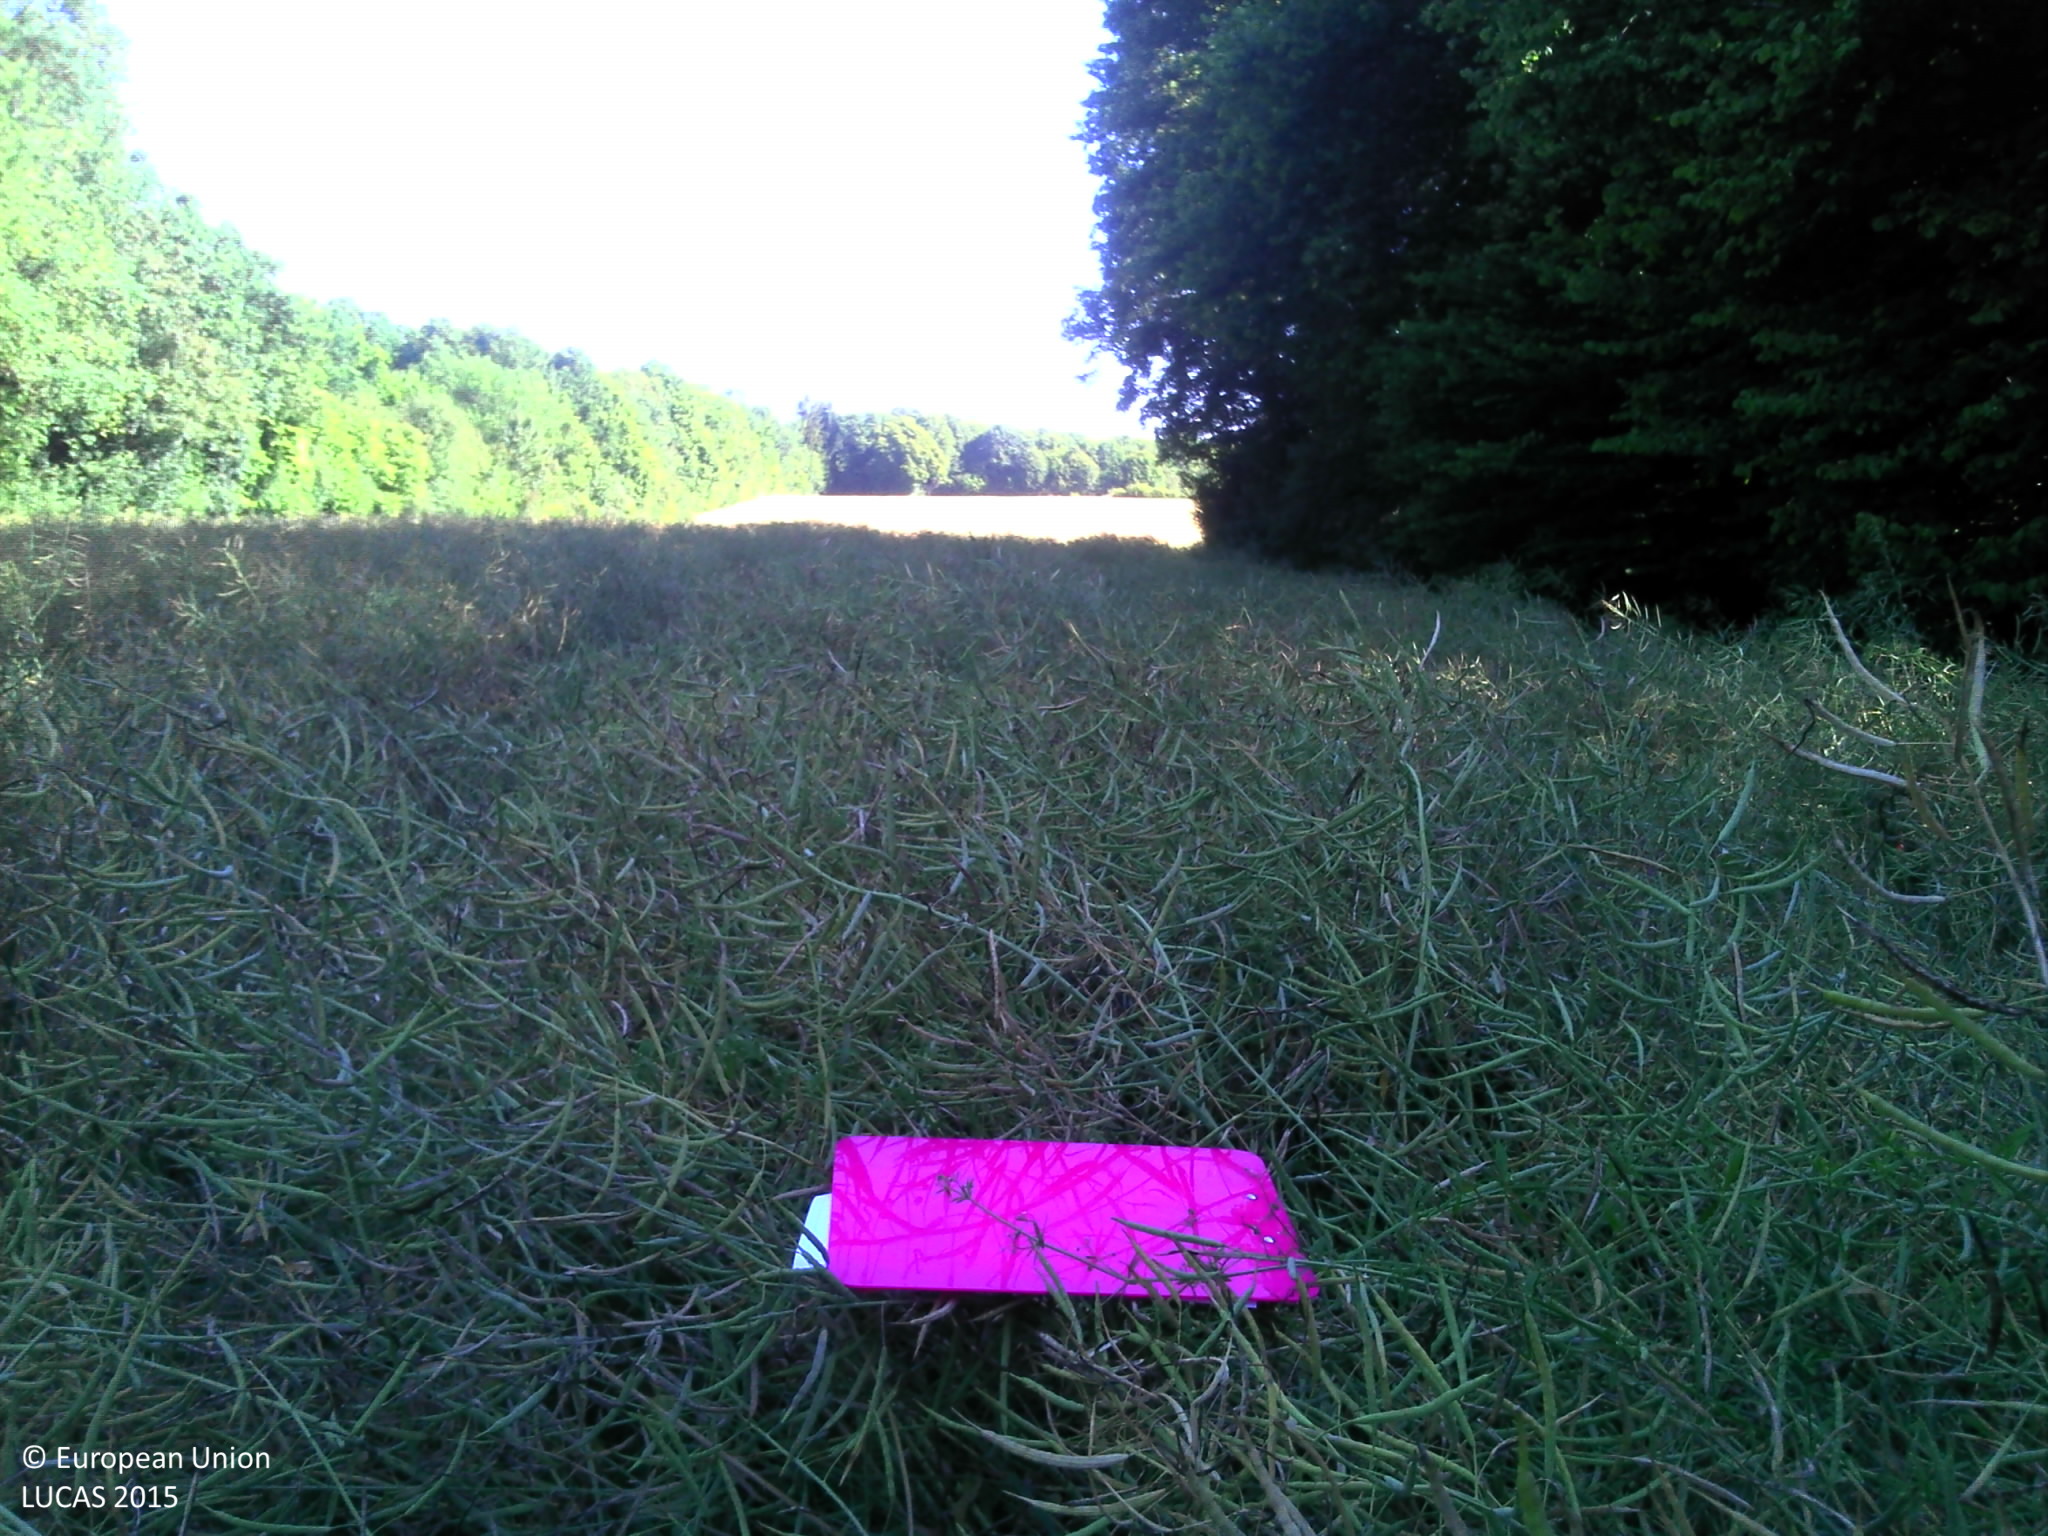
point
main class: Cropland
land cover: Rape and turnip rape
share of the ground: > 75 %
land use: Agriculture (excluding fallow land and kitchen gardens)
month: June
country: FR
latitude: 48.6936
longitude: 5.1484
